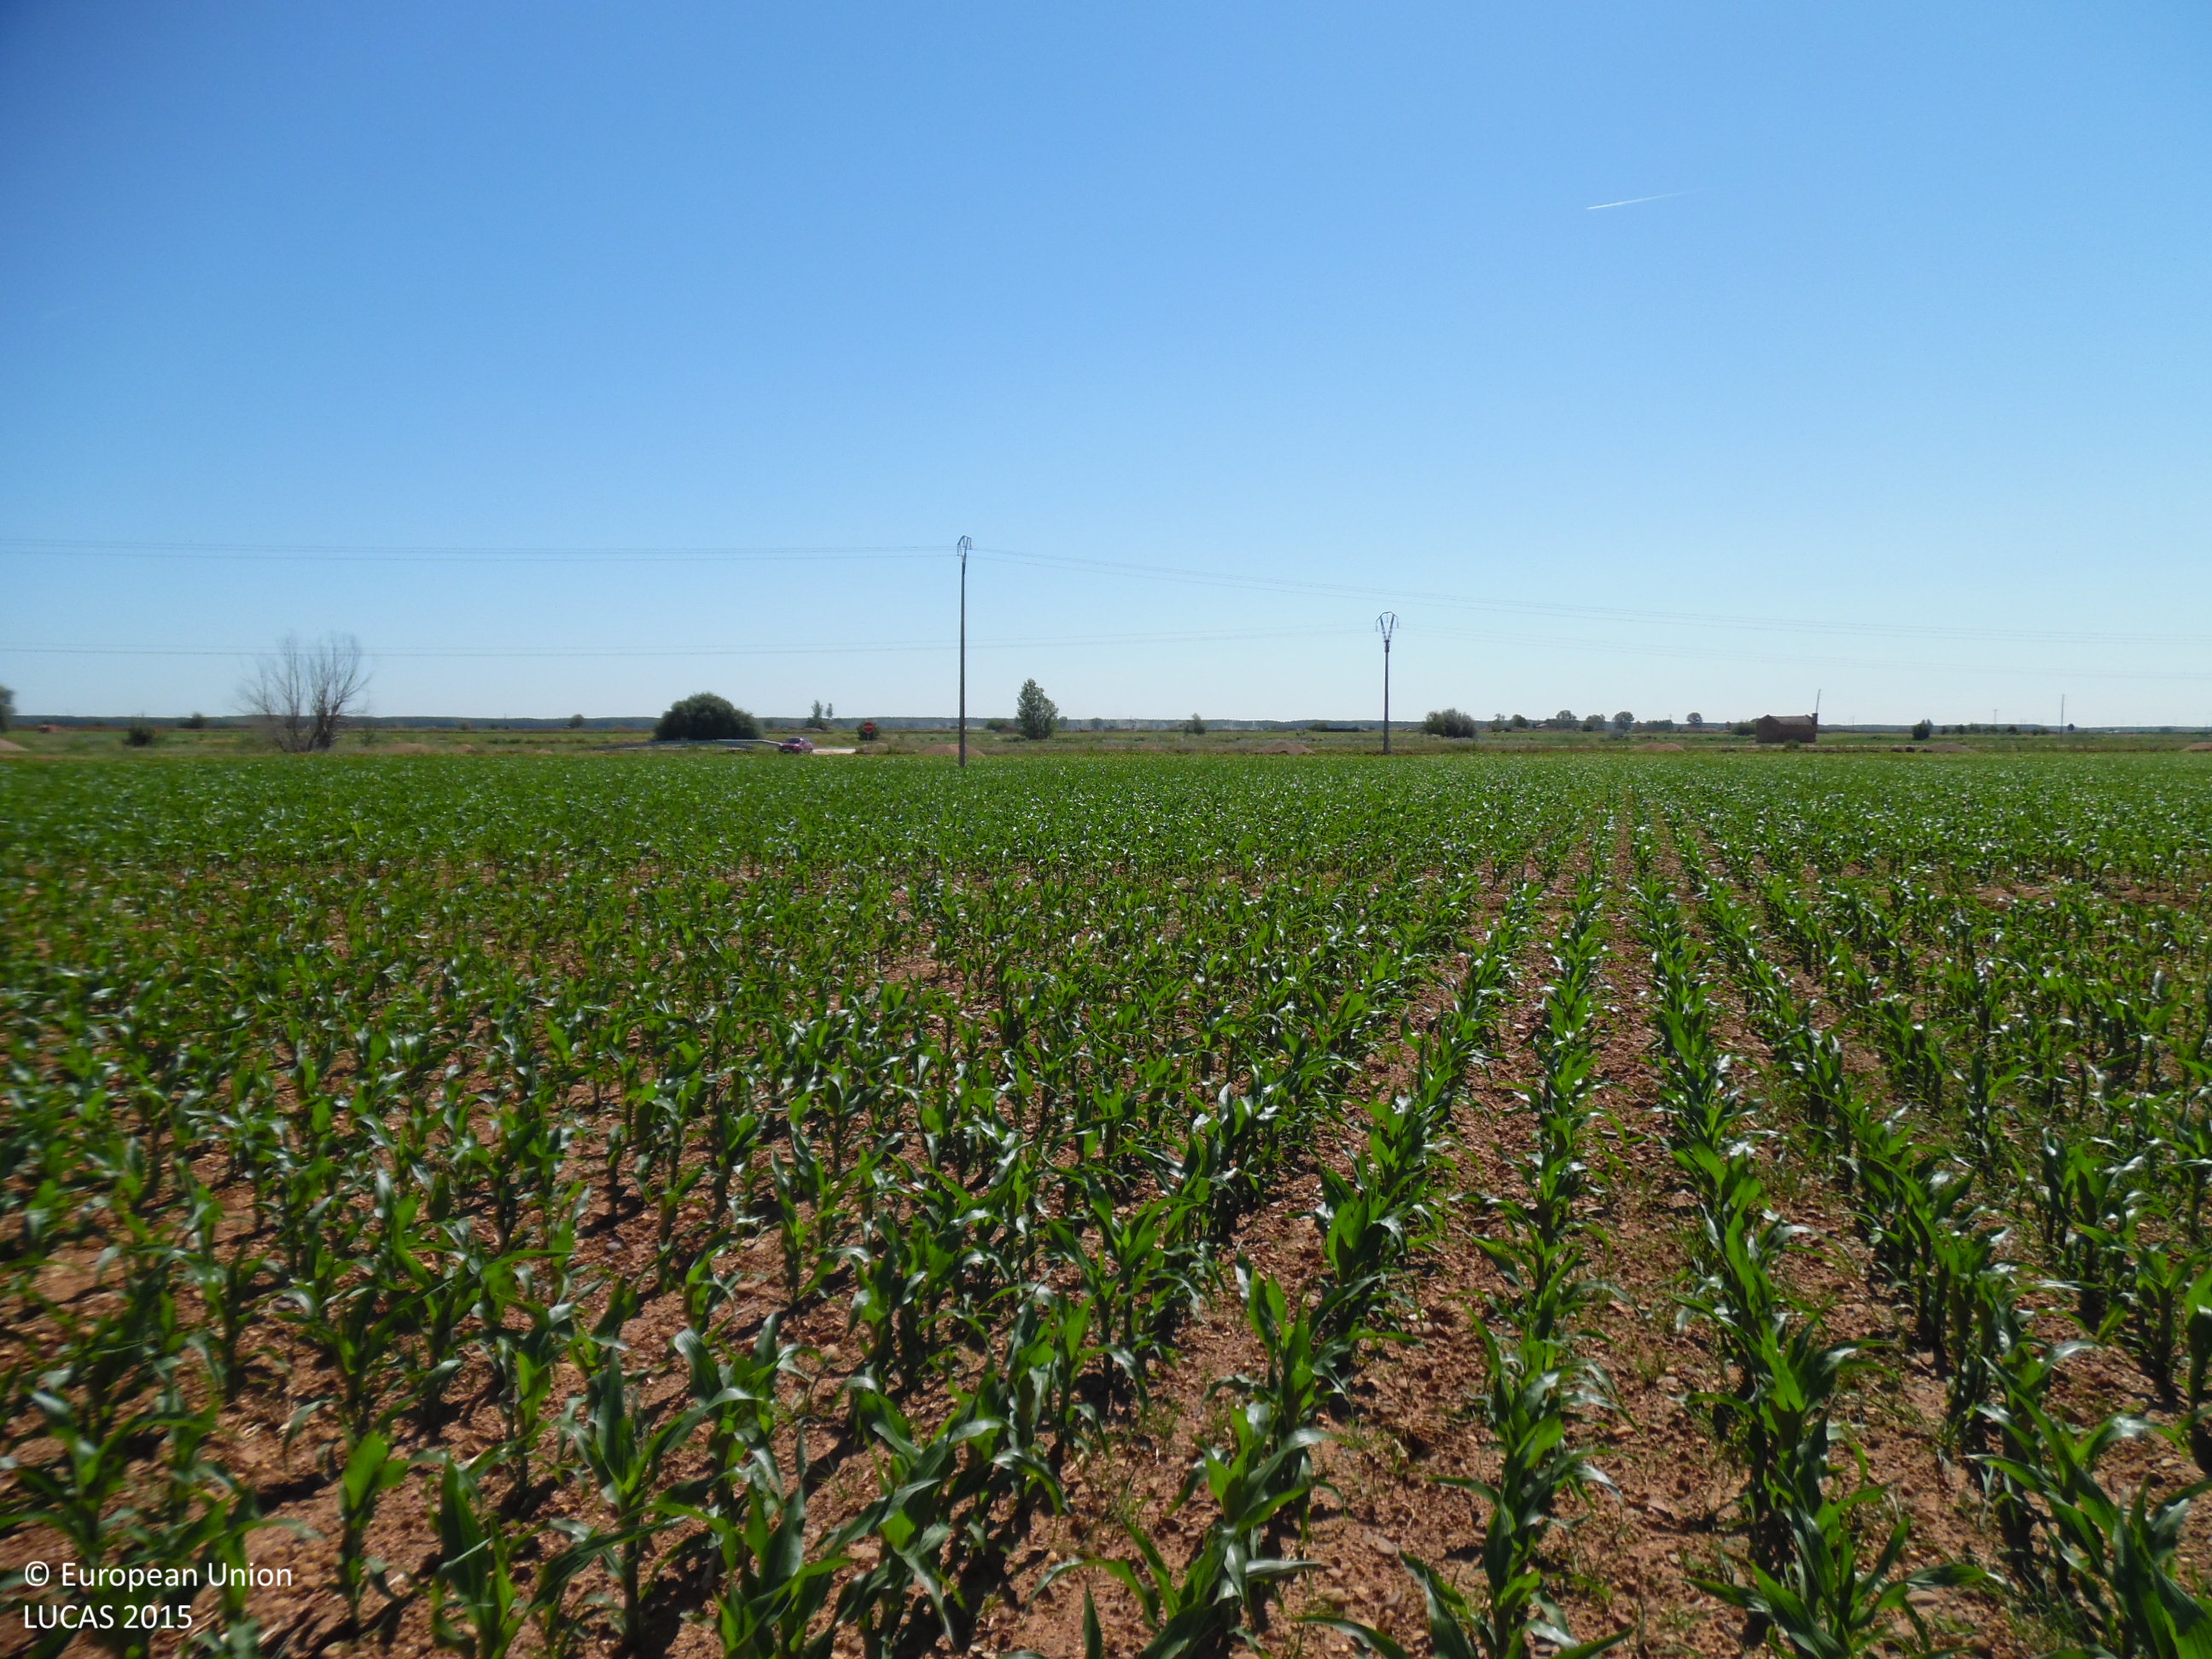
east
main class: Cropland
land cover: Maize
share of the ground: 50 - 75 %
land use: Agriculture (excluding fallow land and kitchen gardens)
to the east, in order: Maize; Electric lines; Maize; Other structural elements; Grass margins; Paved roads, cycling and walking lanes; Grass margins; Maize
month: June
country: ES
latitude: 42.2694
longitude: -5.6746
